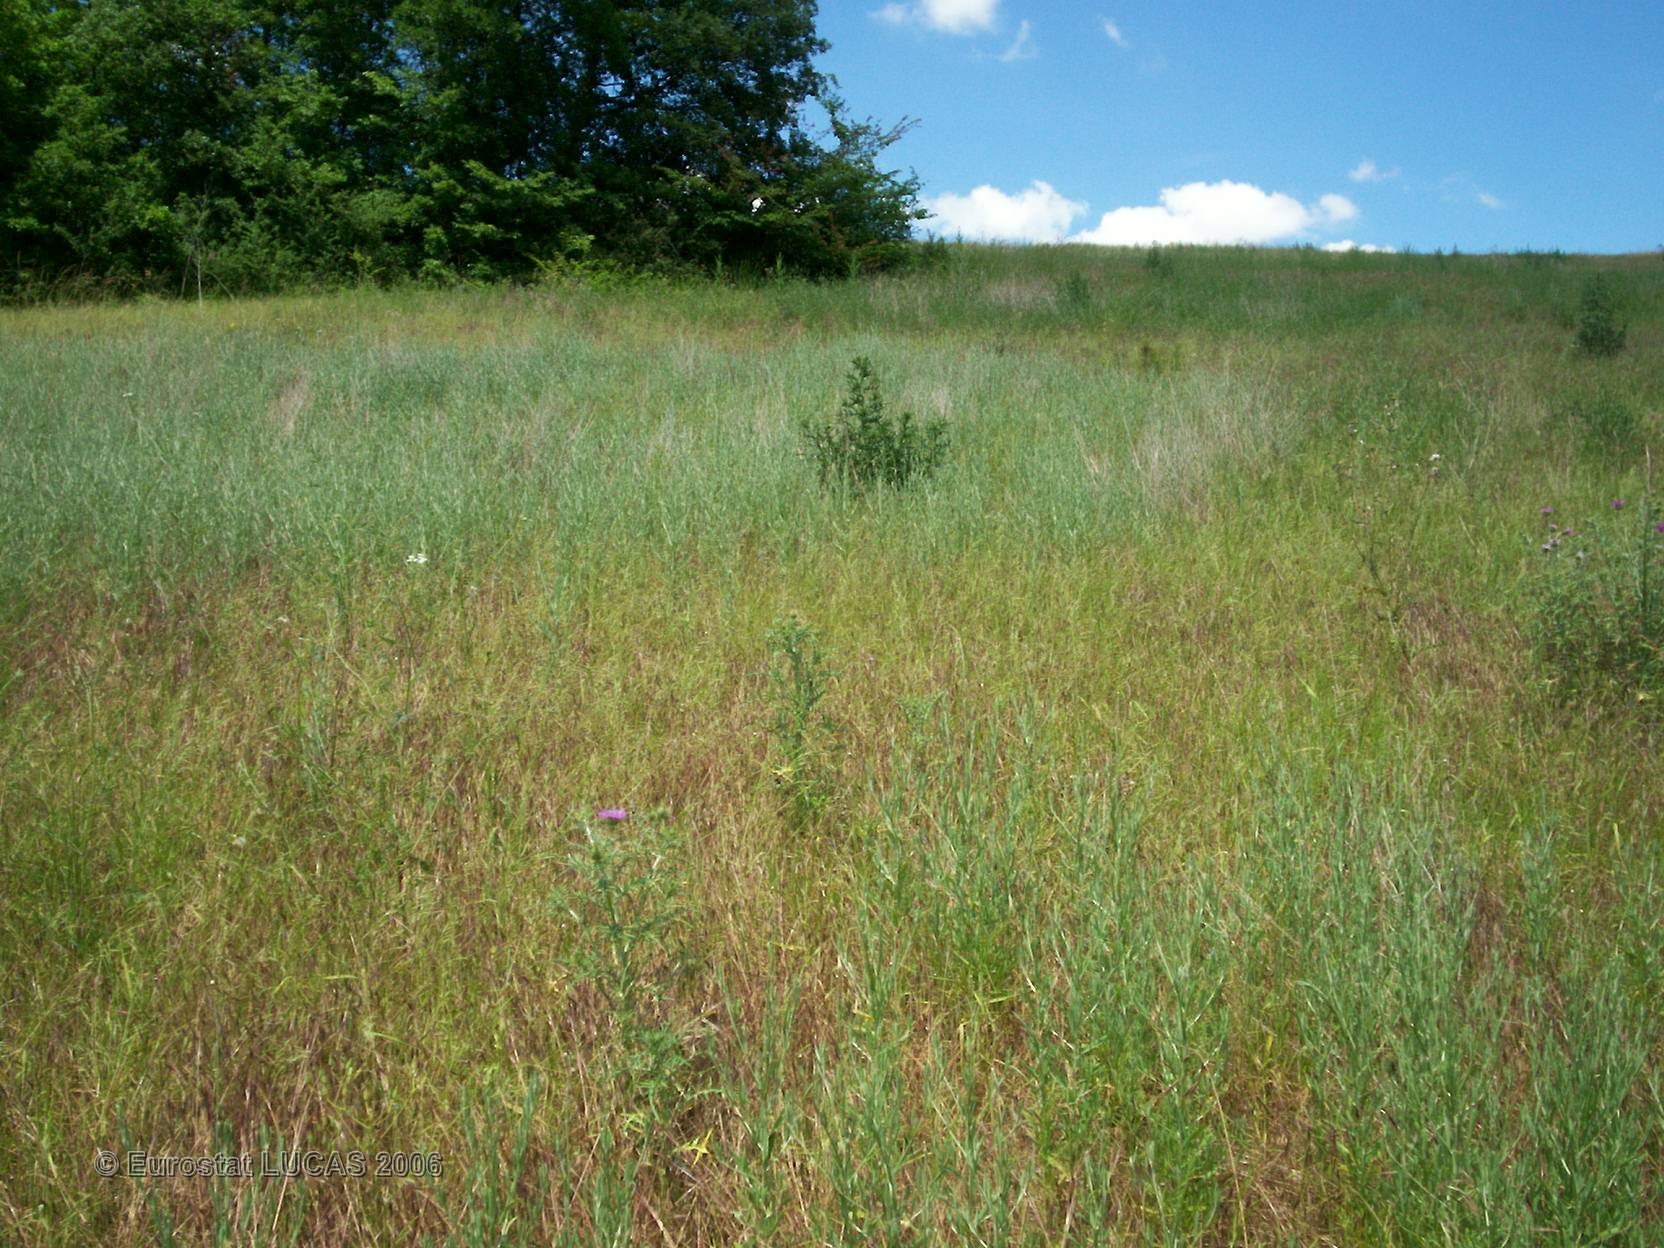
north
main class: Grassland
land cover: Grassland without tree/shrub cover
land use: Agriculture (excluding fallow land and kitchen gardens)
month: May
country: FR
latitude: 43.4502
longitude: 0.9927
